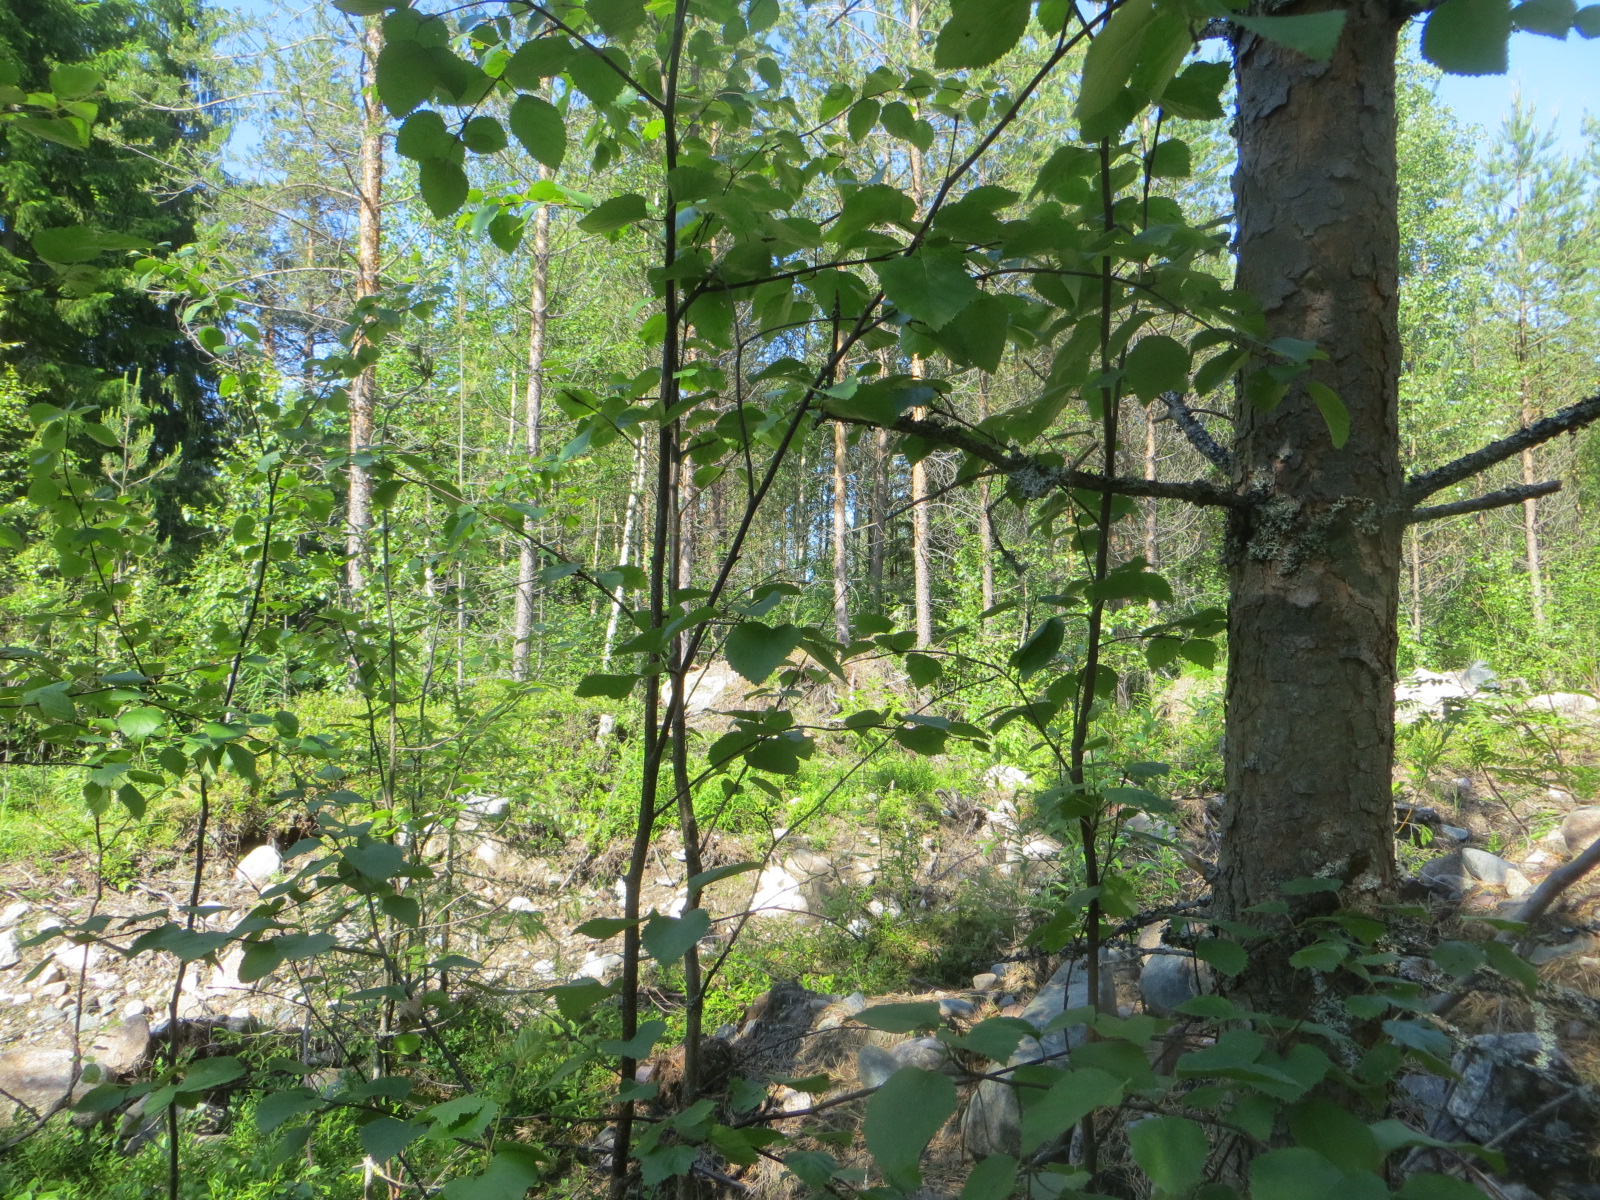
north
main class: Woodland
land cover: Pine dominated mixed woodland
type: boreal forest
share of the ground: > 75 %
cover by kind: coniferous forest trees 55 %, shrubs 25 %, broadleaved forest trees 20 %
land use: Forestry
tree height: > 5 m
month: July
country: FI
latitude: 65.3847
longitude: 25.3304
